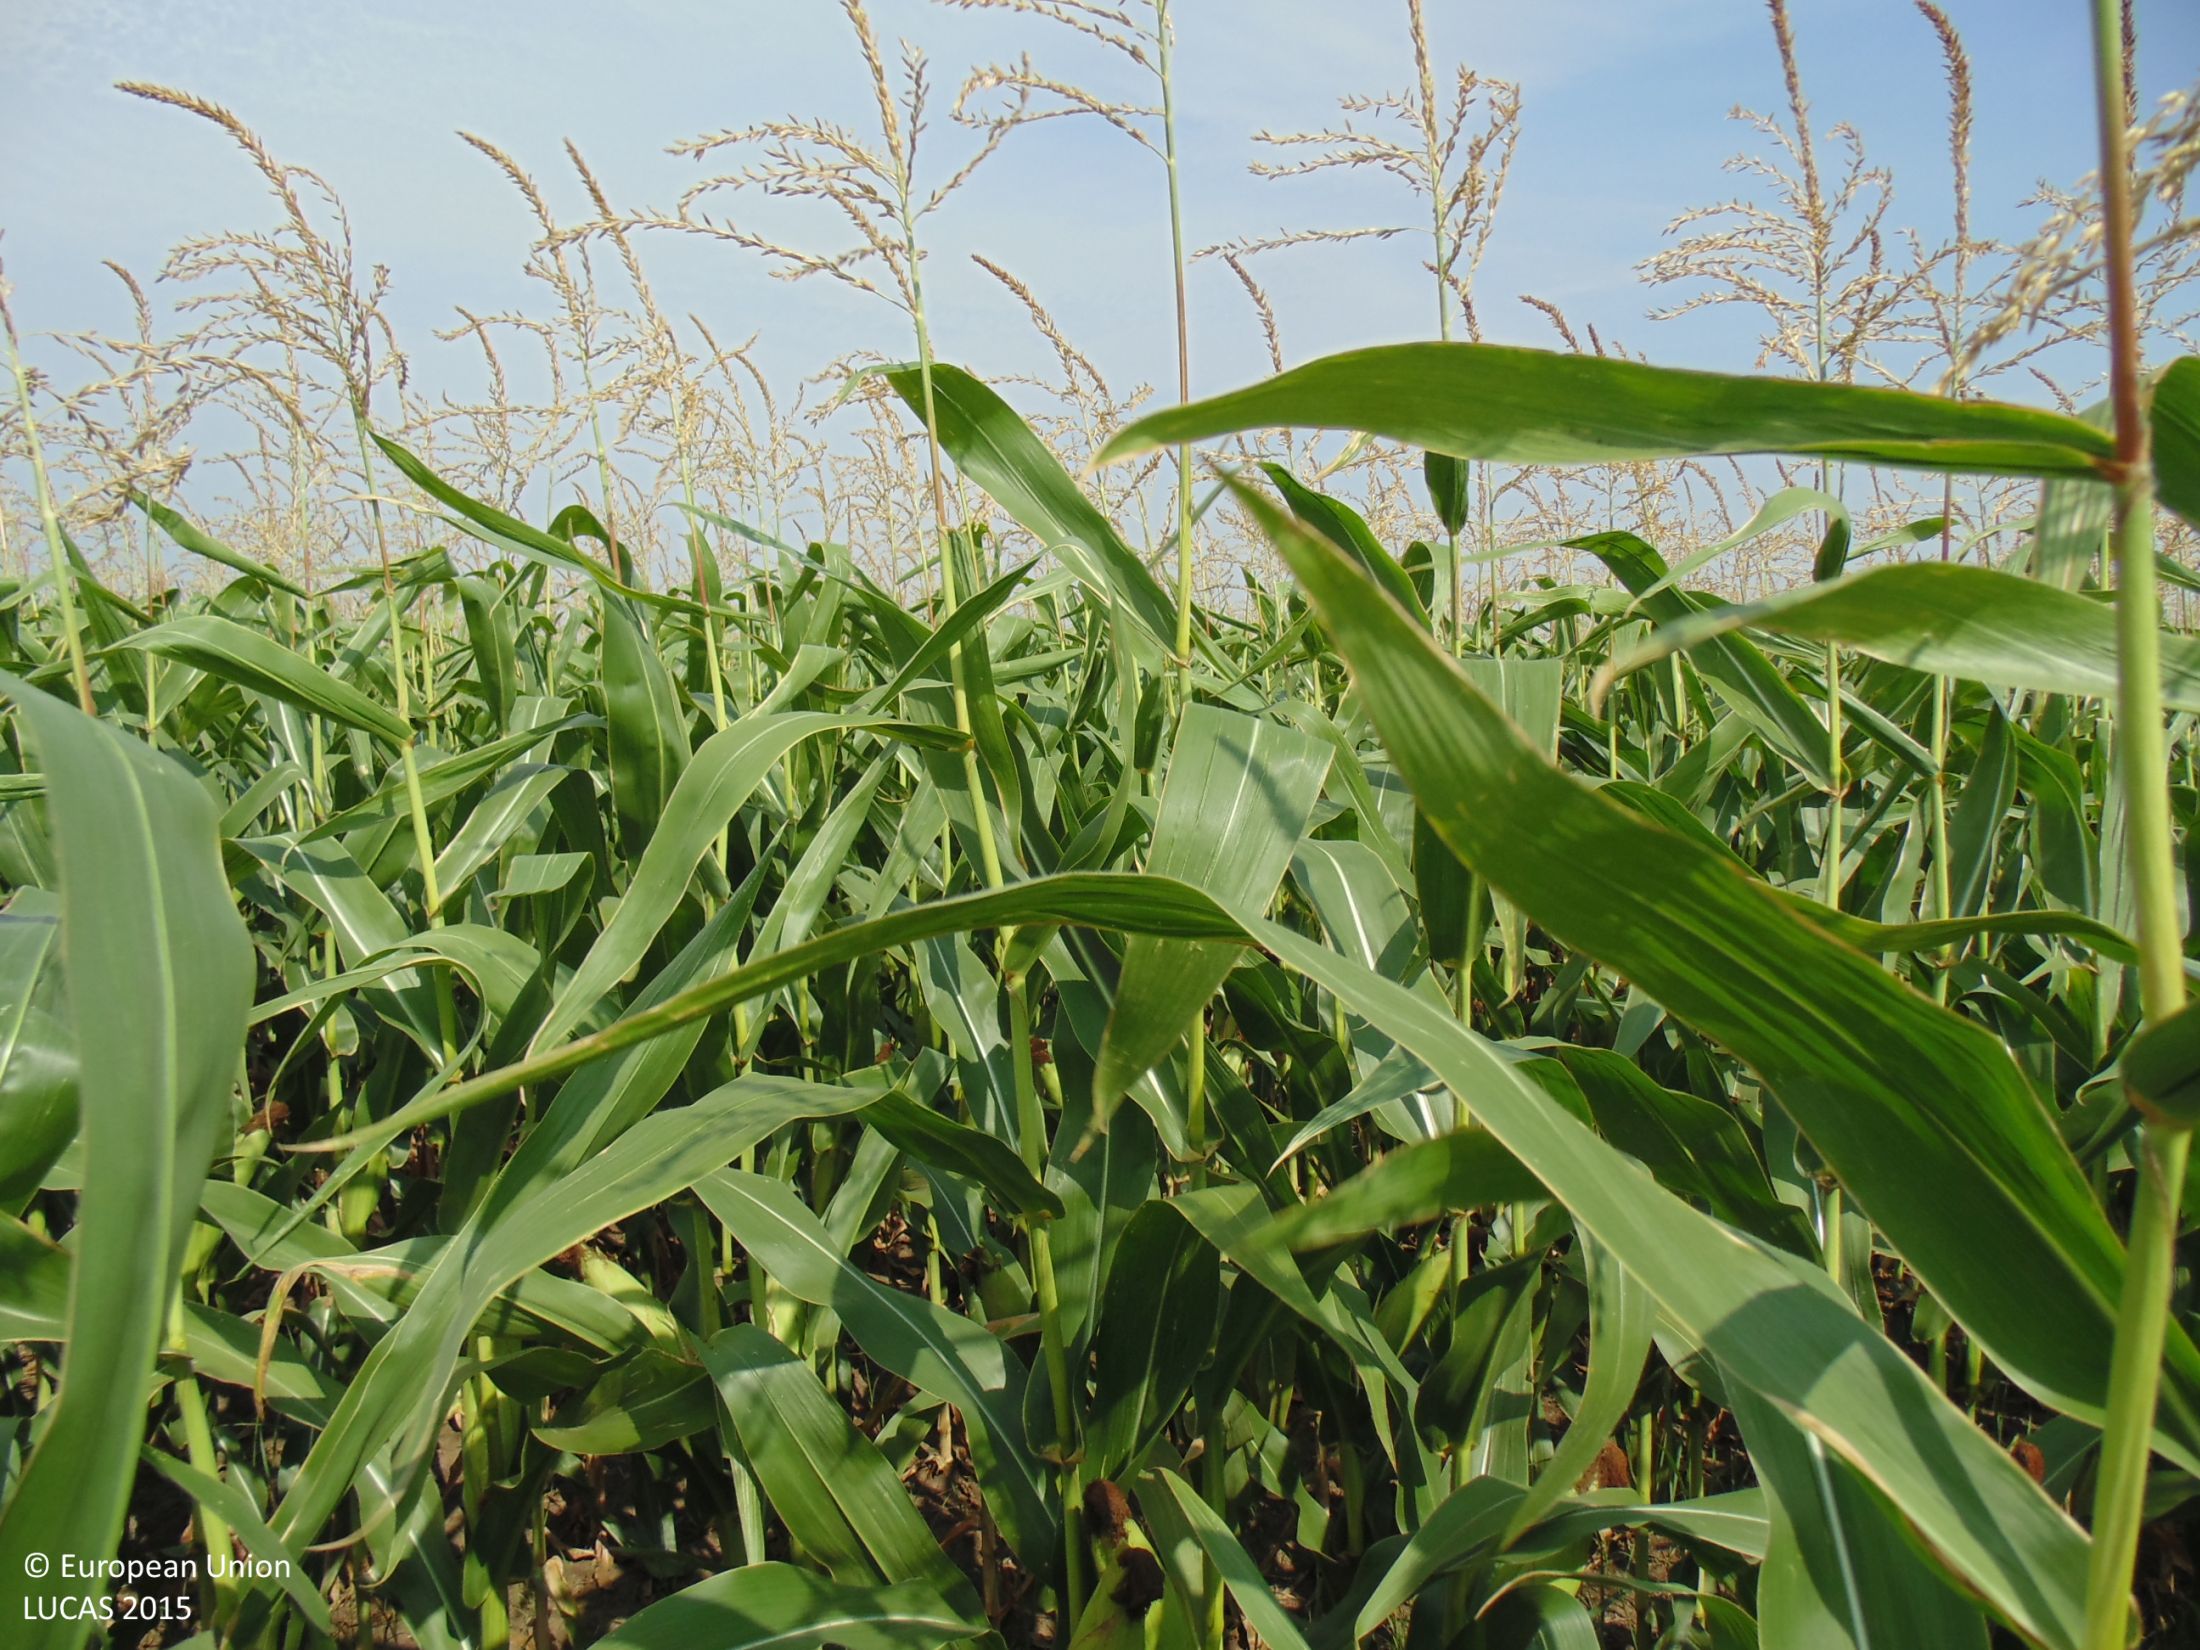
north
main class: Cropland
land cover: Maize
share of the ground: > 75 %
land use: Agriculture (excluding fallow land and kitchen gardens)
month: August
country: BG
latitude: 43.8226
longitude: 28.0434
